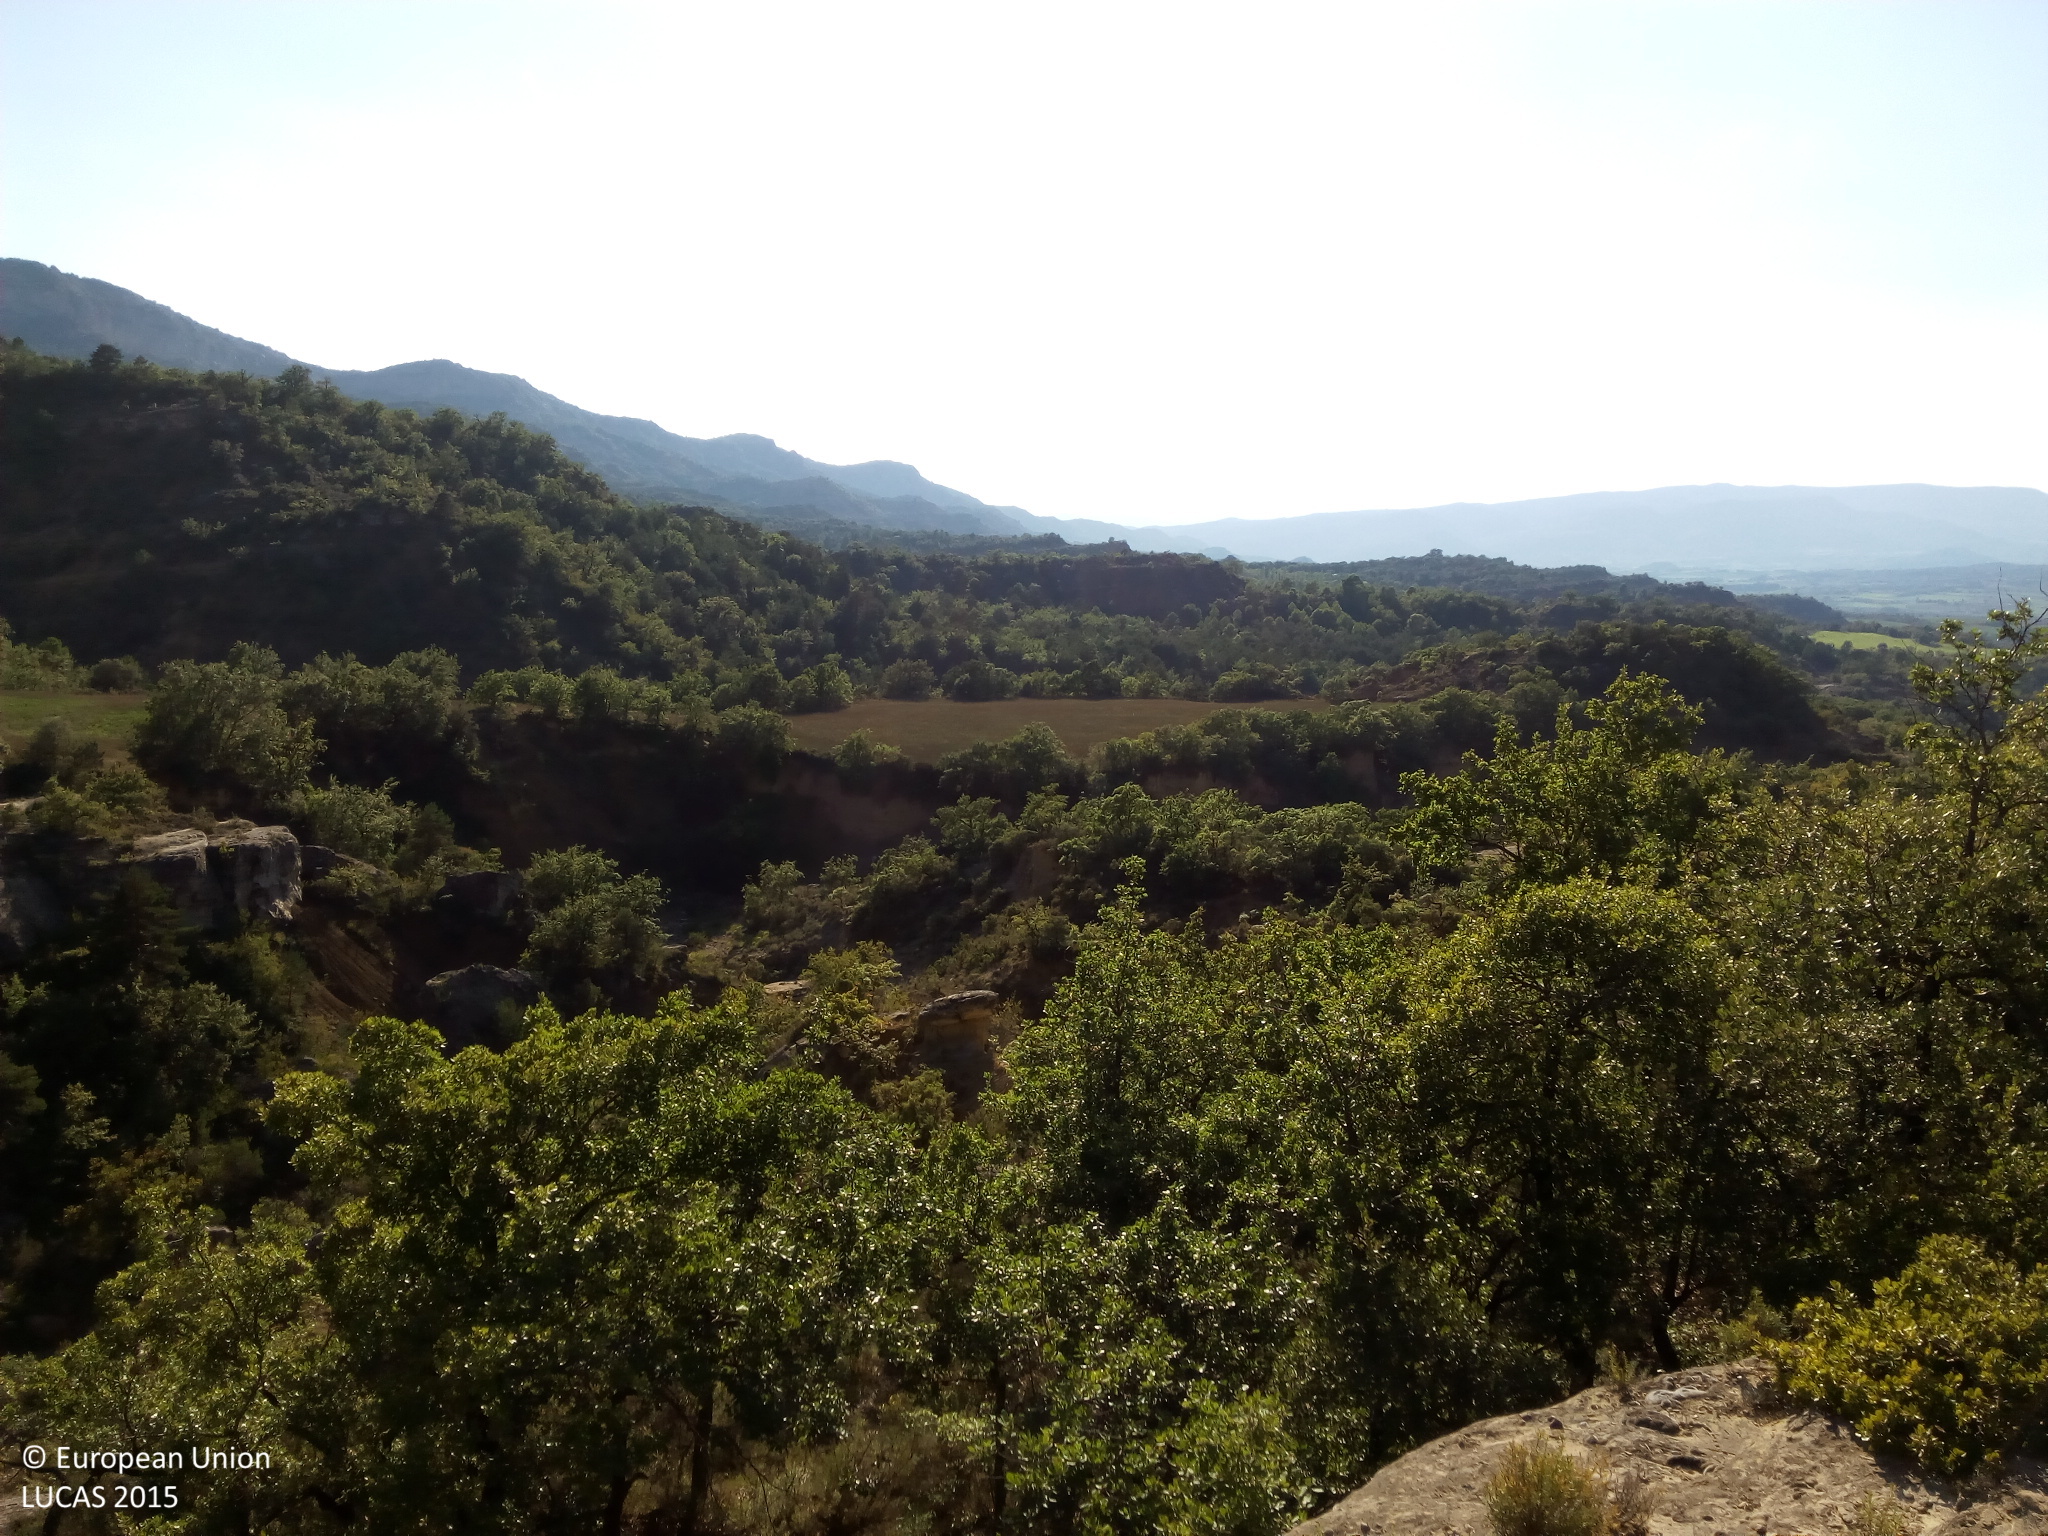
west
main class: Shrubland
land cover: Shrubland with sparse tree cover
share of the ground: > 75 %
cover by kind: consolidated bare surface 50 %, unconsolidated bare surface 30 %, shrubs 15 %, broadleaved forest trees 5 %
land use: Semi-natural and natural areas not in use
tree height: < 5 m
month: August
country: ES
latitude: 42.1840
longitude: 0.4536
